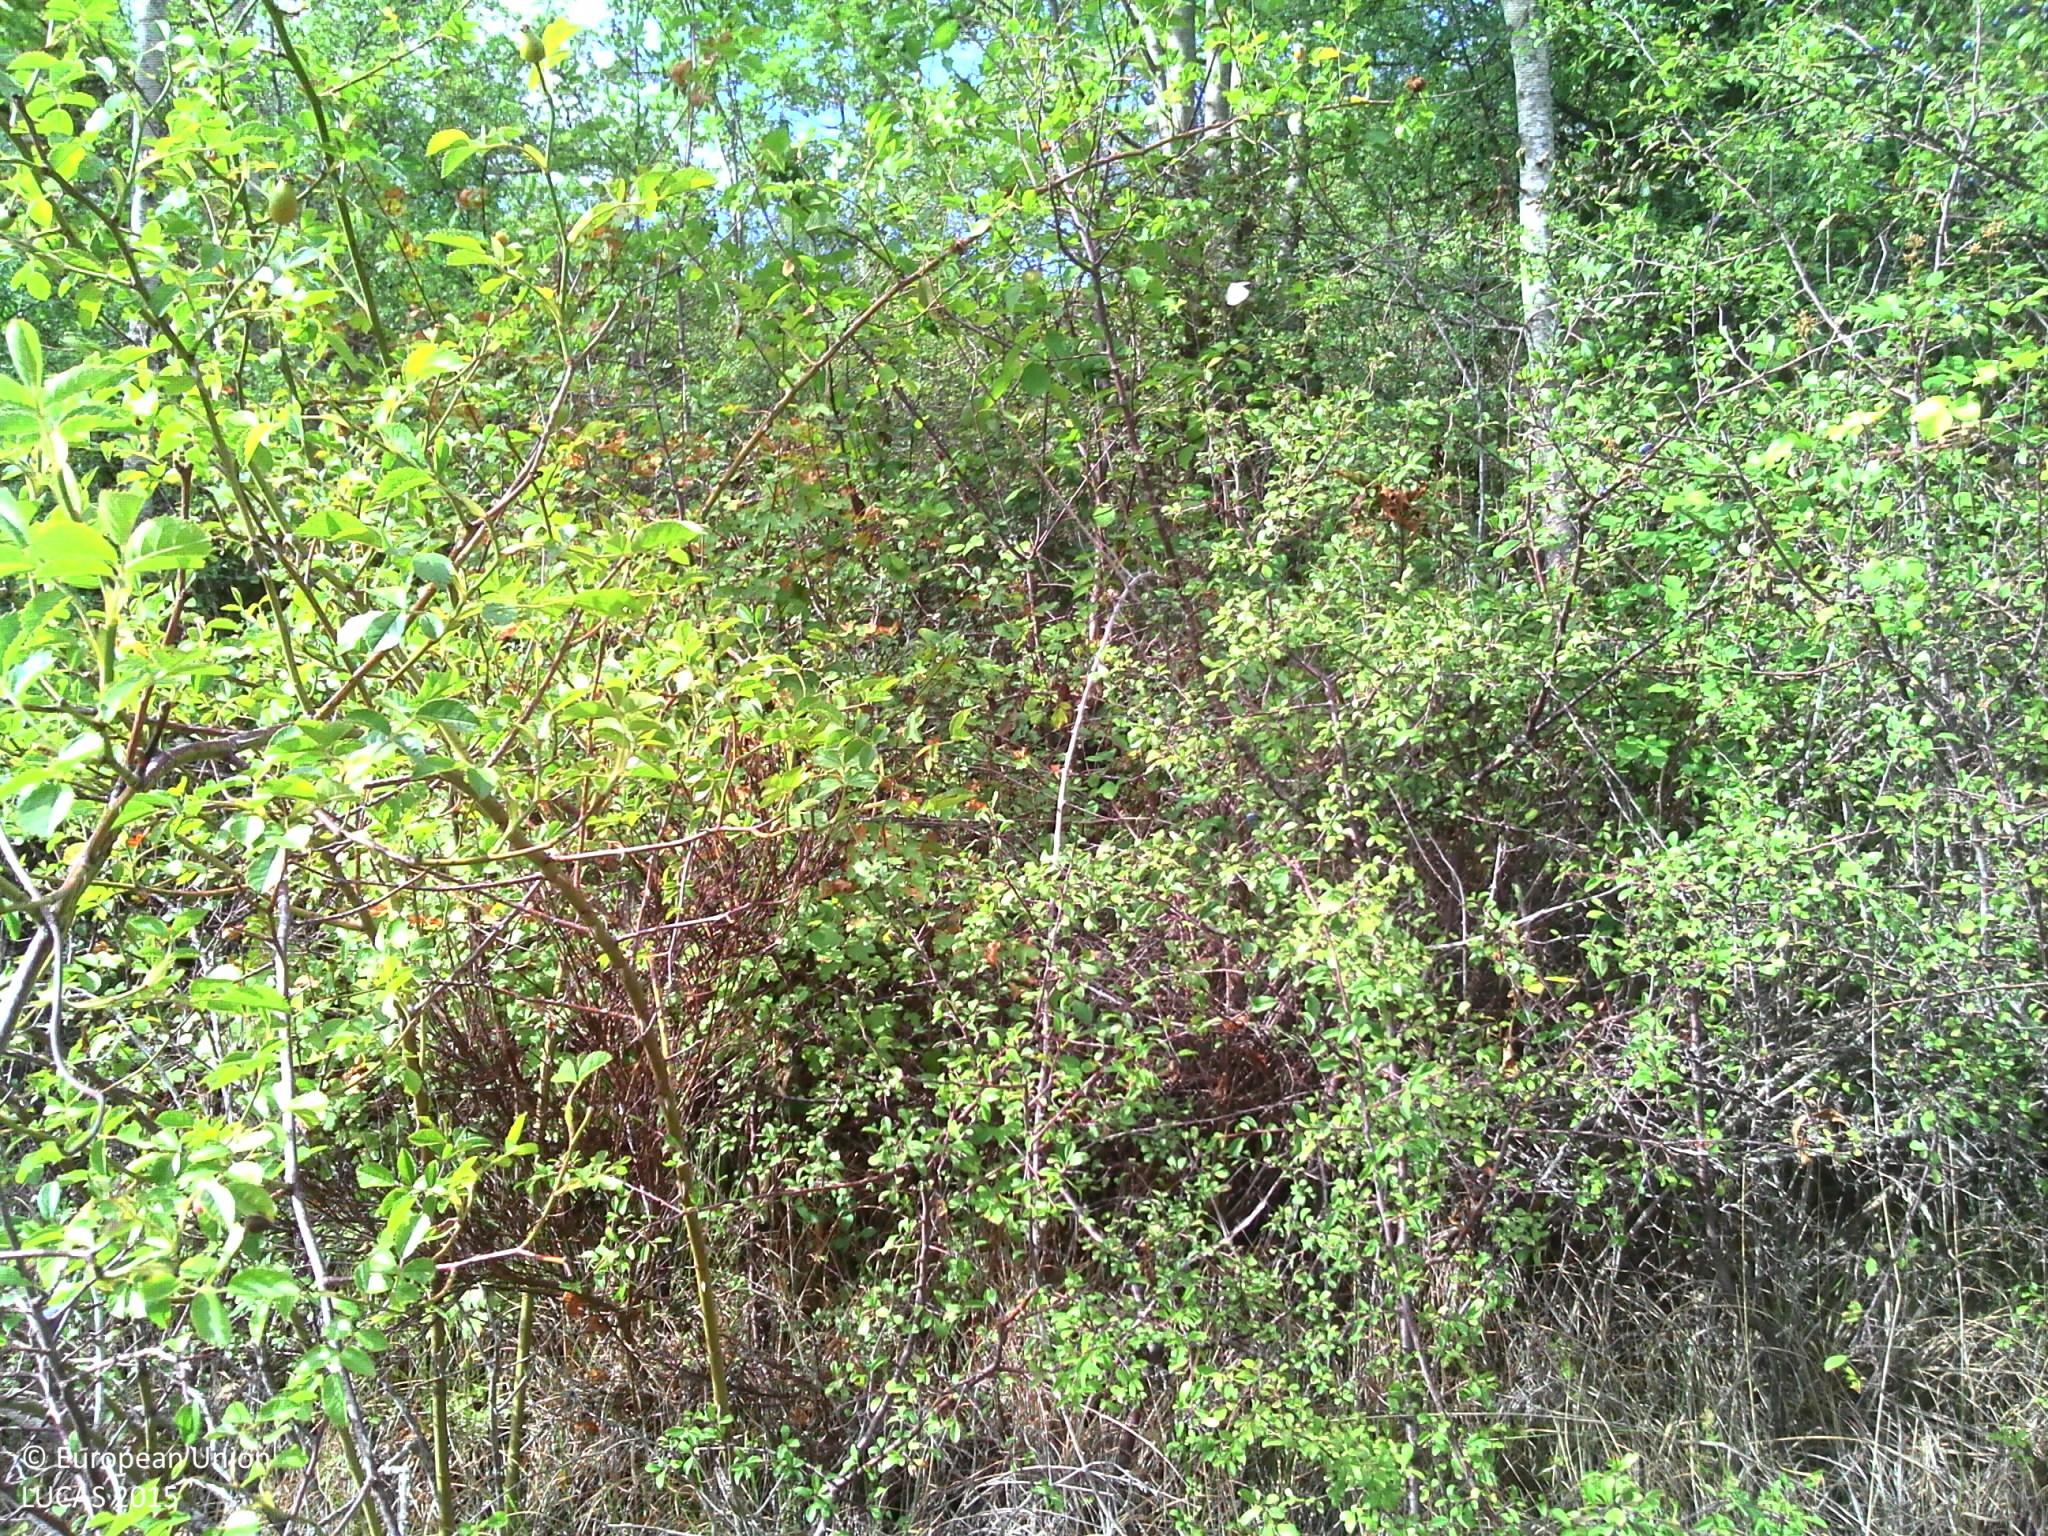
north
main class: Shrubland
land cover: Shrubland with sparse tree cover
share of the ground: > 75 %
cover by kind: shrubs 60 %, herbaceous plants 30 %, broadleaved forest trees 5 %, lichens and mosses 5 %
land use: Semi-natural and natural areas not in use
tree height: < 5 m
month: August
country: FR
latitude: 46.0311
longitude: 4.5375
